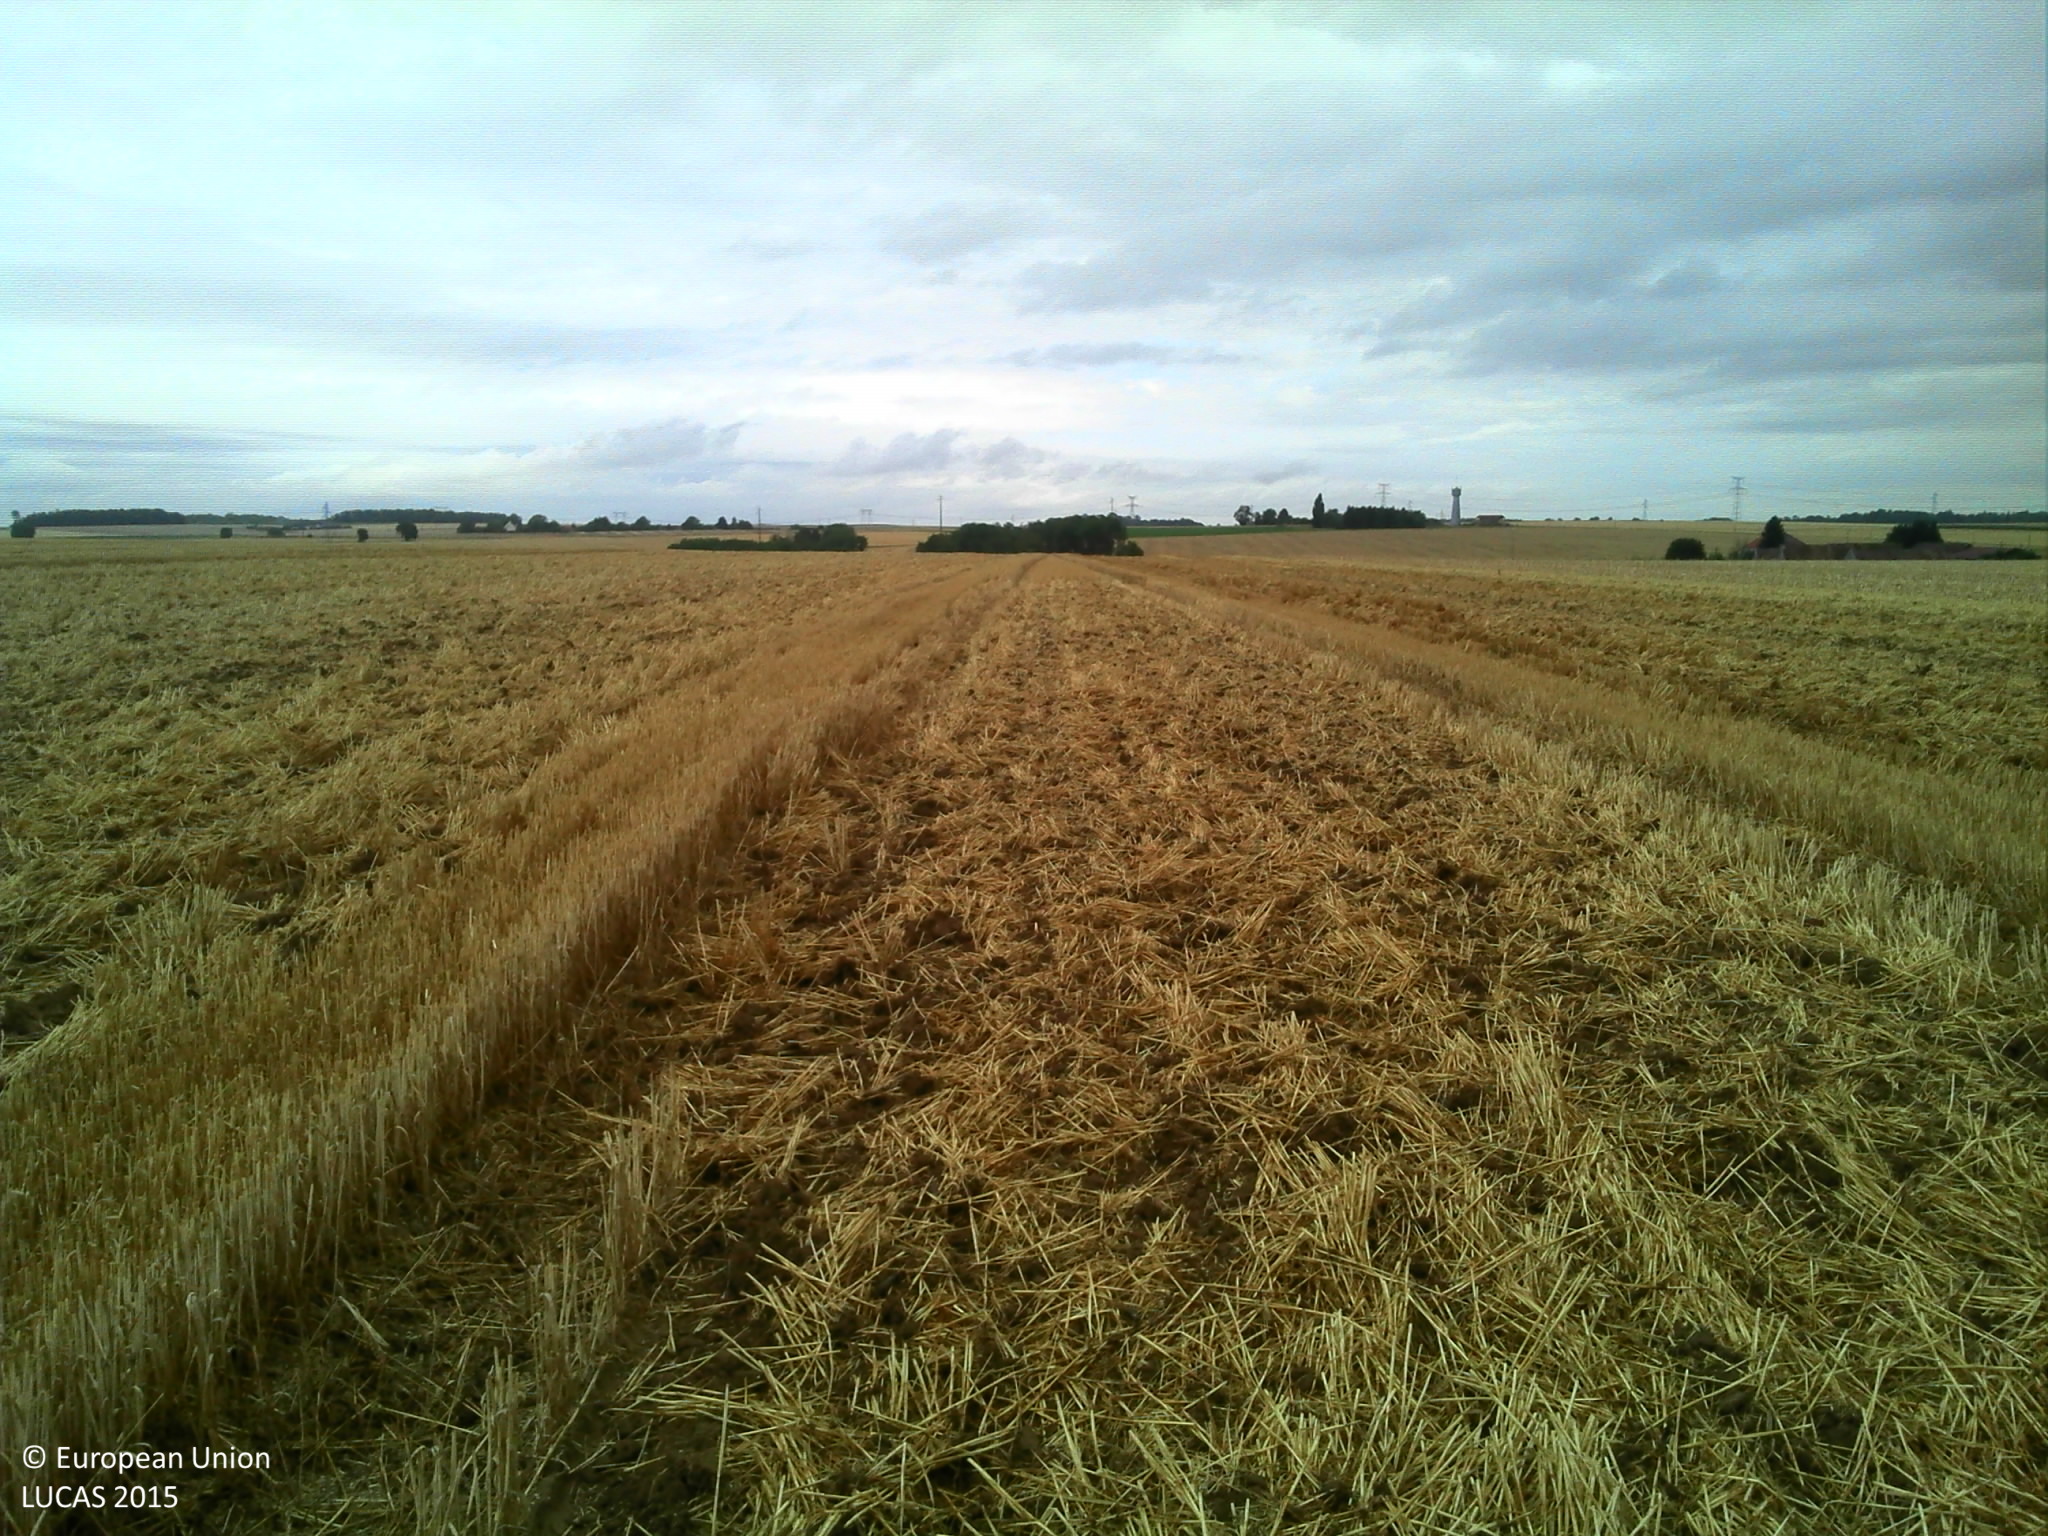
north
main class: Cropland
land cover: Common wheat
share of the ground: > 75 %
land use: Agriculture (excluding fallow land and kitchen gardens)
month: August
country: FR
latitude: 48.5637
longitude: 3.3398
